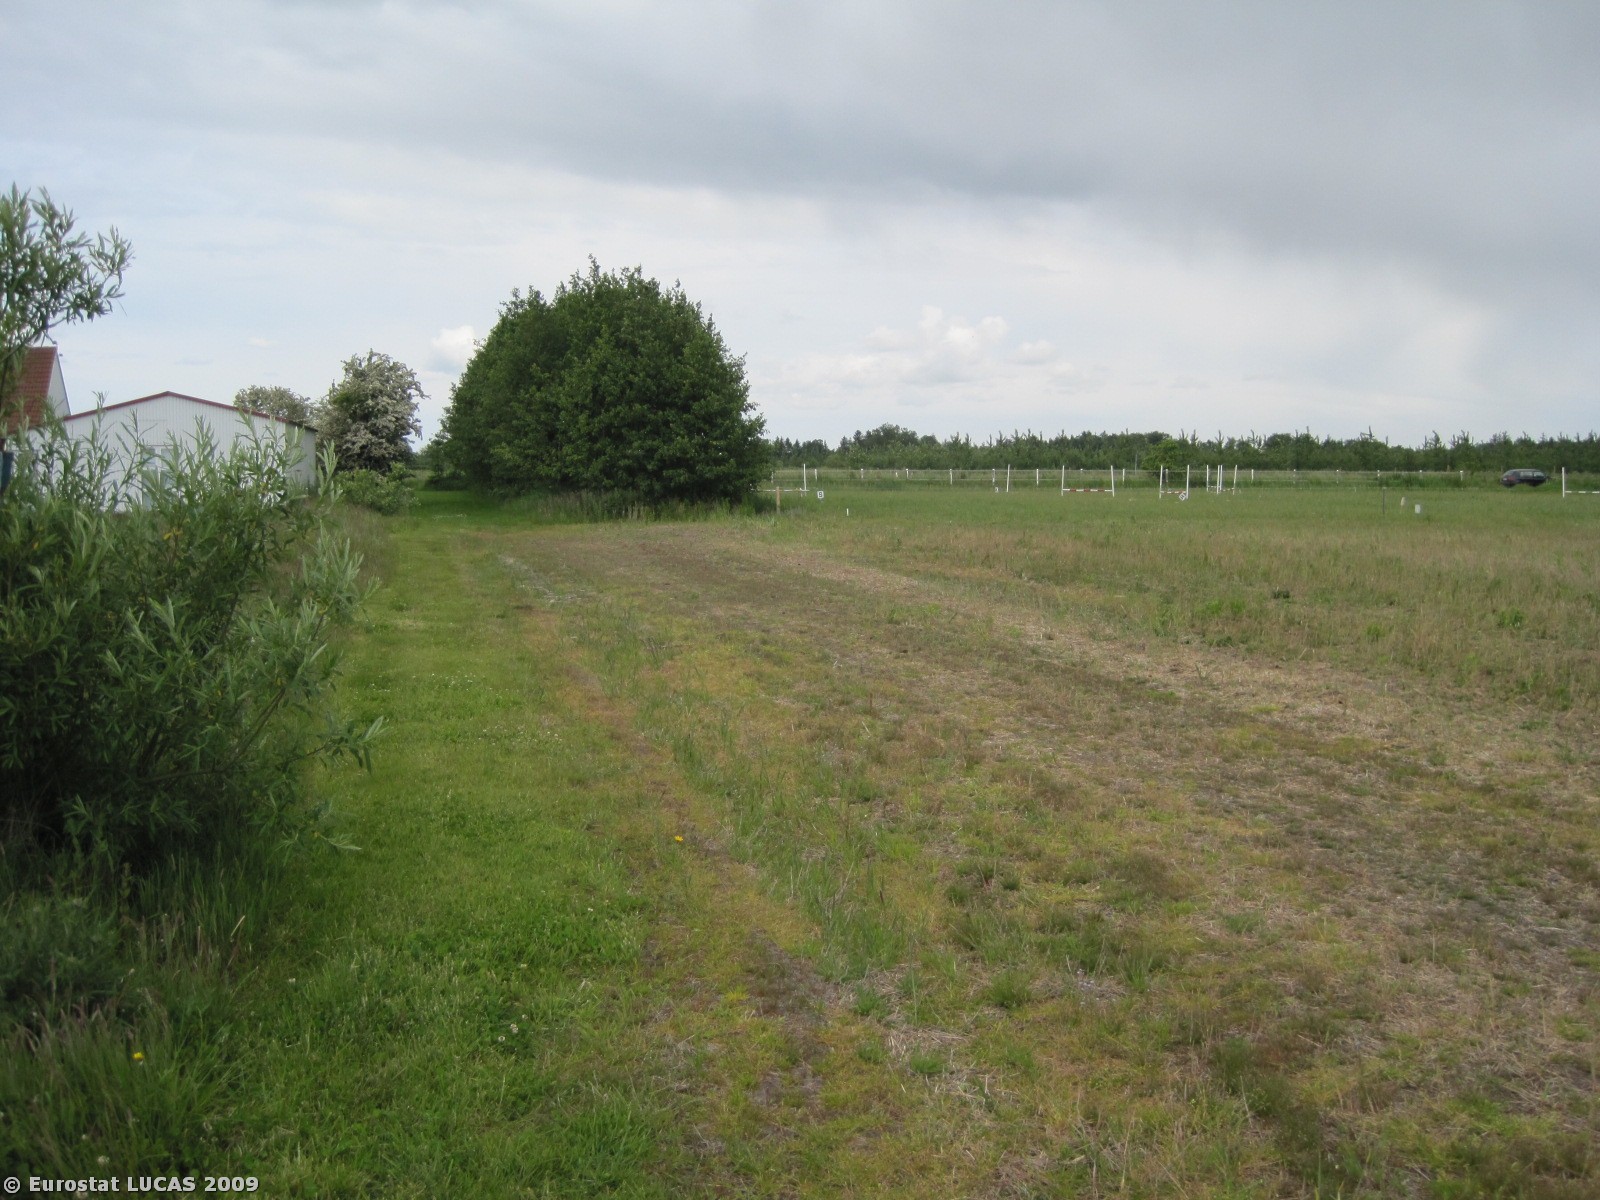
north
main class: Grassland
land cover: Grassland without tree/shrub cover
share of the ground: > 75 %
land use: Agriculture (excluding fallow land and kitchen gardens)
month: June
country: DK
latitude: 56.9964
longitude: 10.2794
